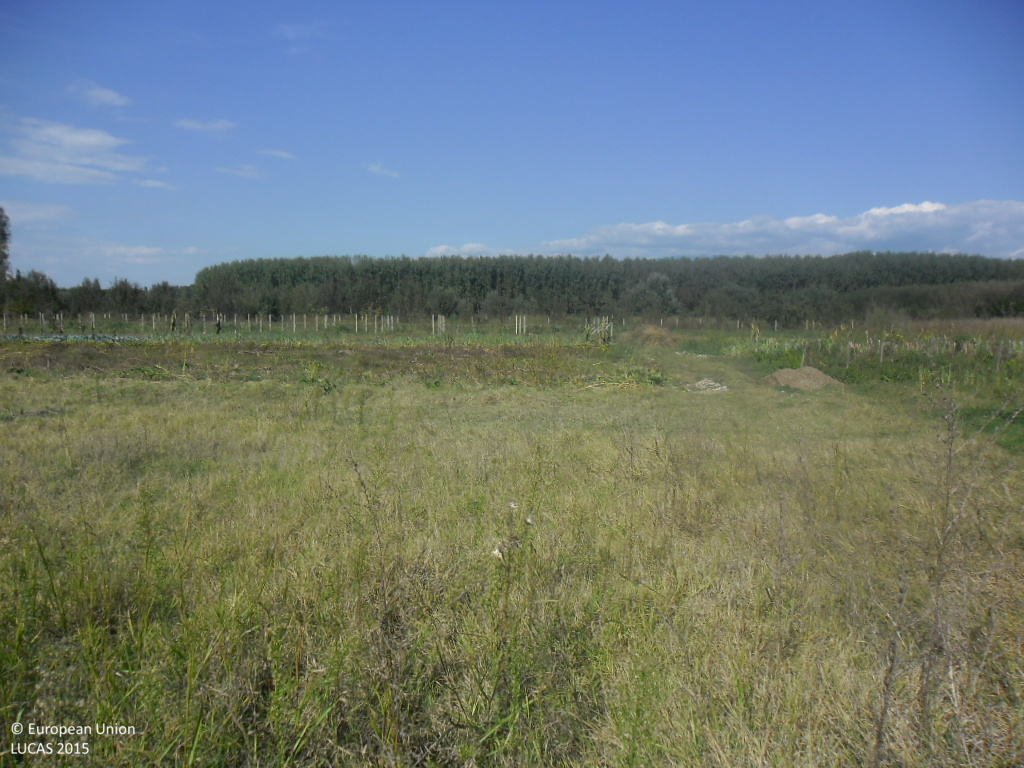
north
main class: Grassland
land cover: Spontaneously vegetated surfaces
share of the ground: > 75 %
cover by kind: herbaceous plants 100 %
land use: Agriculture (excluding fallow land and kitchen gardens)
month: October
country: BG
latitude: 41.4023
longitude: 23.3340
